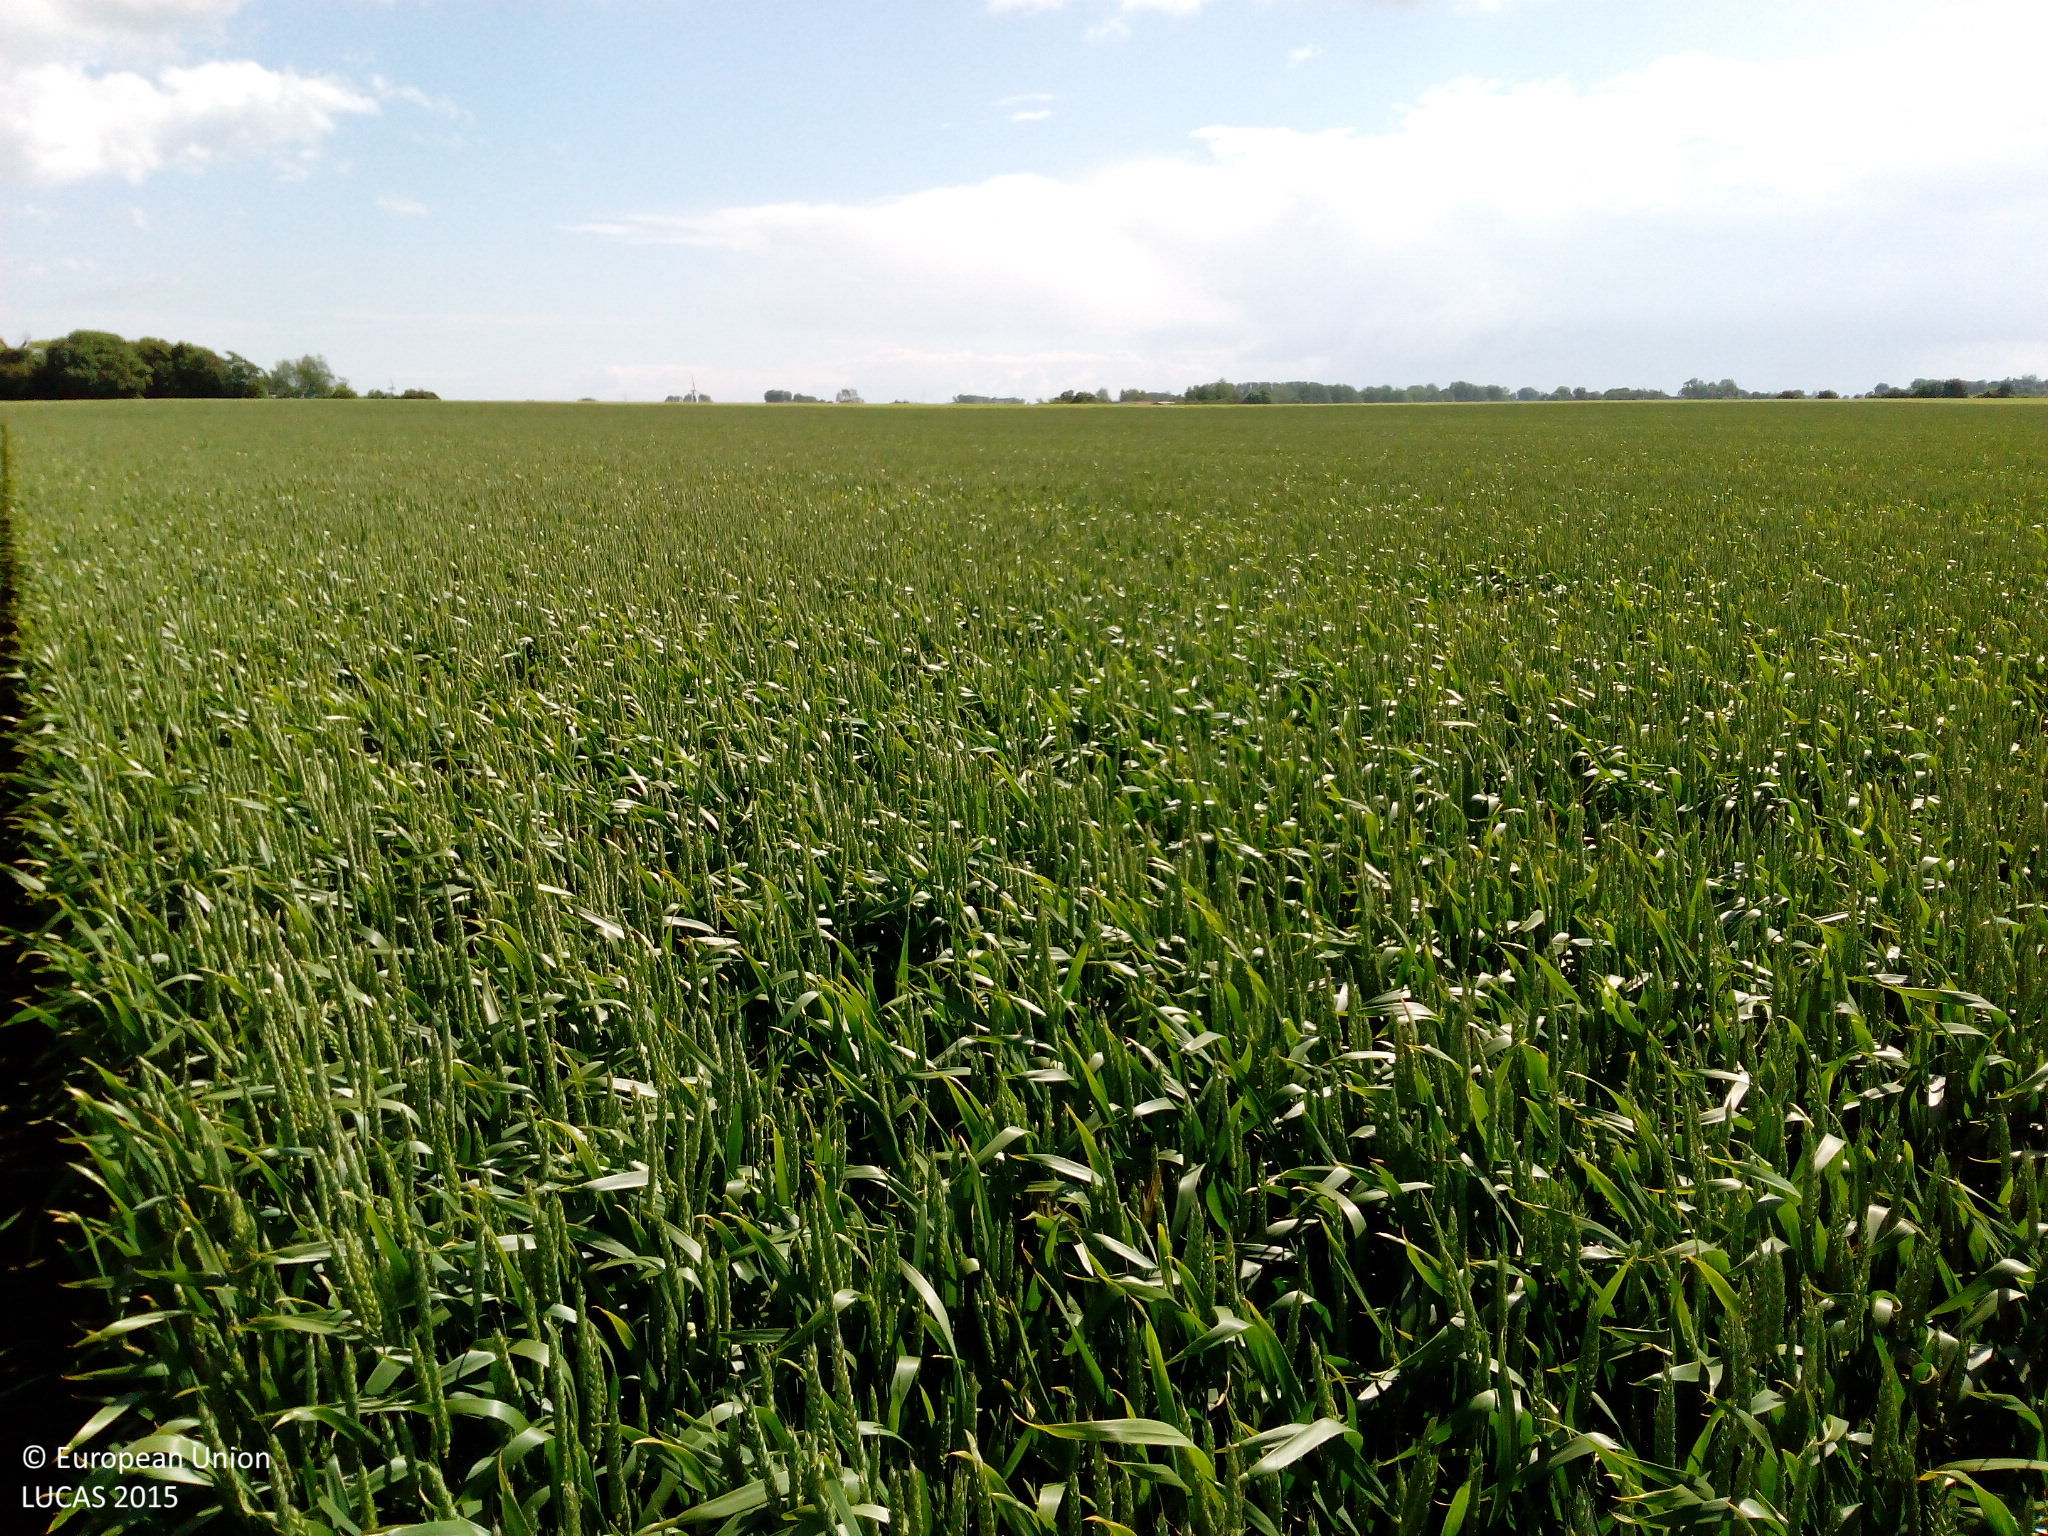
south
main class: Cropland
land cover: Common wheat
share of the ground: > 75 %
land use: Agriculture (excluding fallow land and kitchen gardens)
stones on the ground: < 10 %
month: June
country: DK
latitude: 54.9244
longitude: 11.1382
